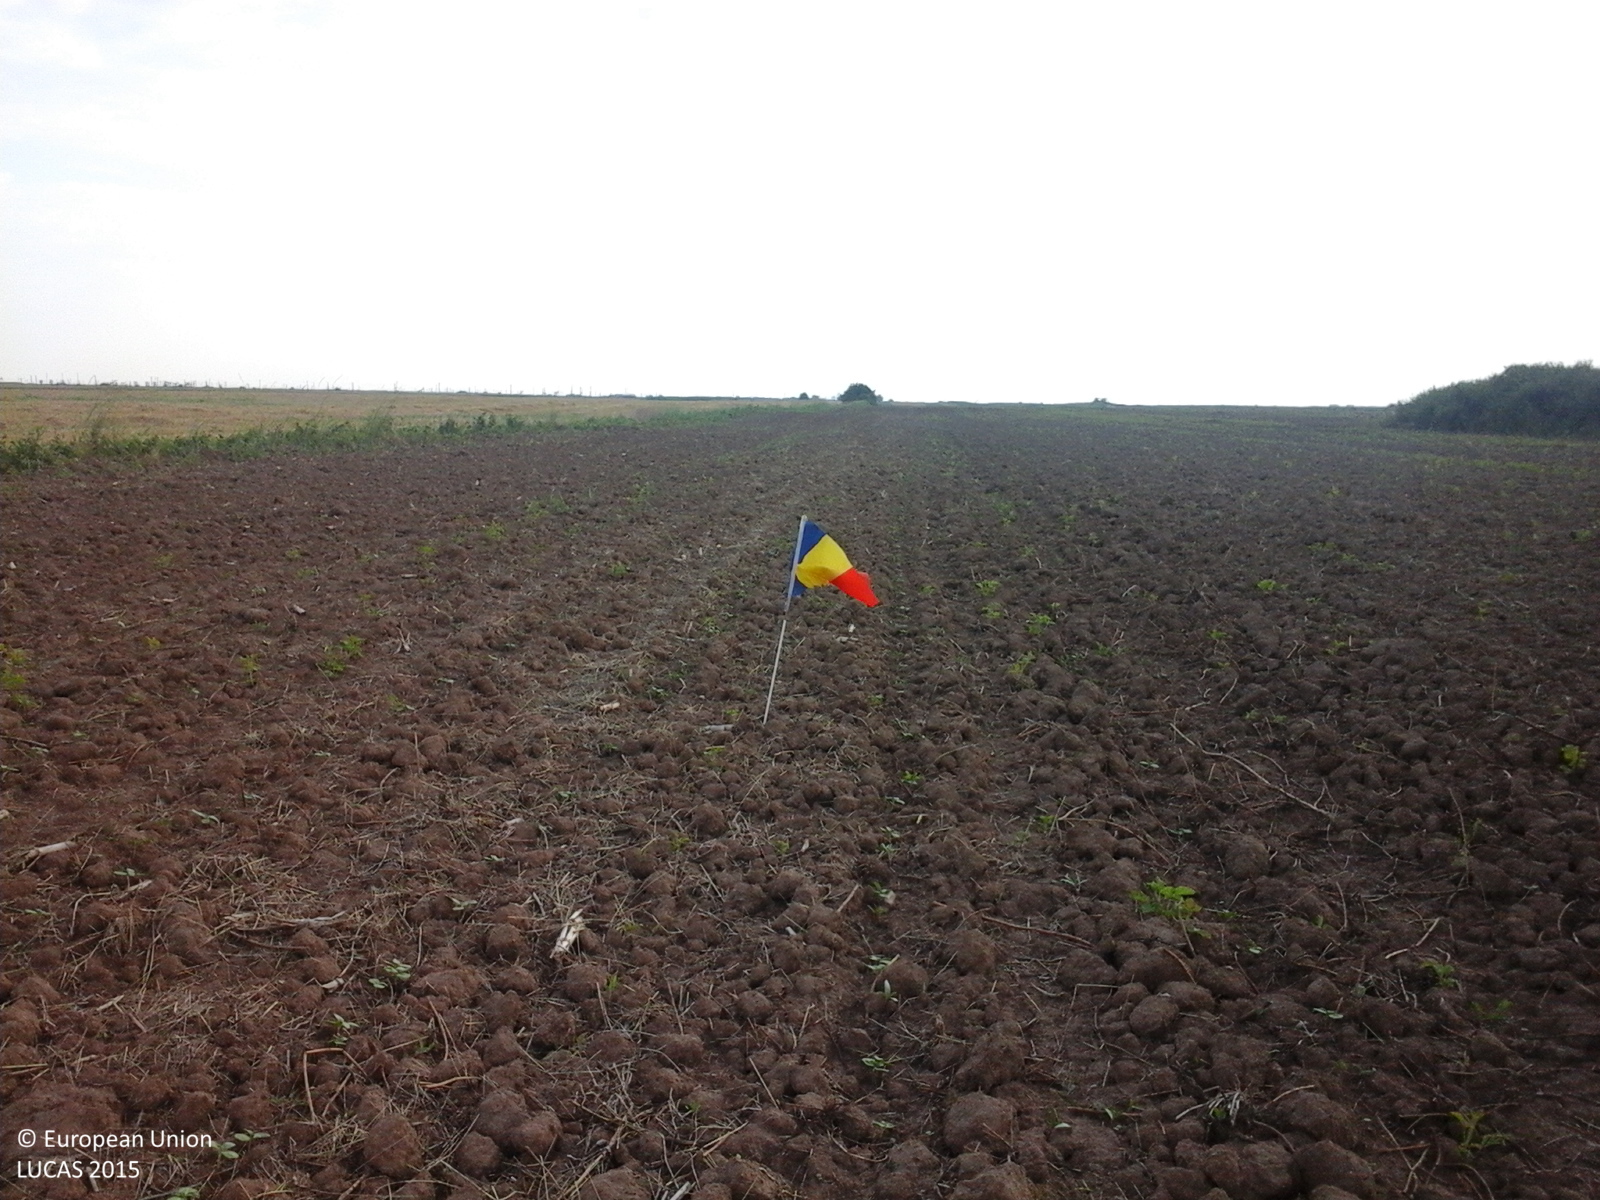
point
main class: Cropland
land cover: Sunflower
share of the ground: < 10 %
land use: Agriculture (excluding fallow land and kitchen gardens)
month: July
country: RO
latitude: 44.3387
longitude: 25.5819
